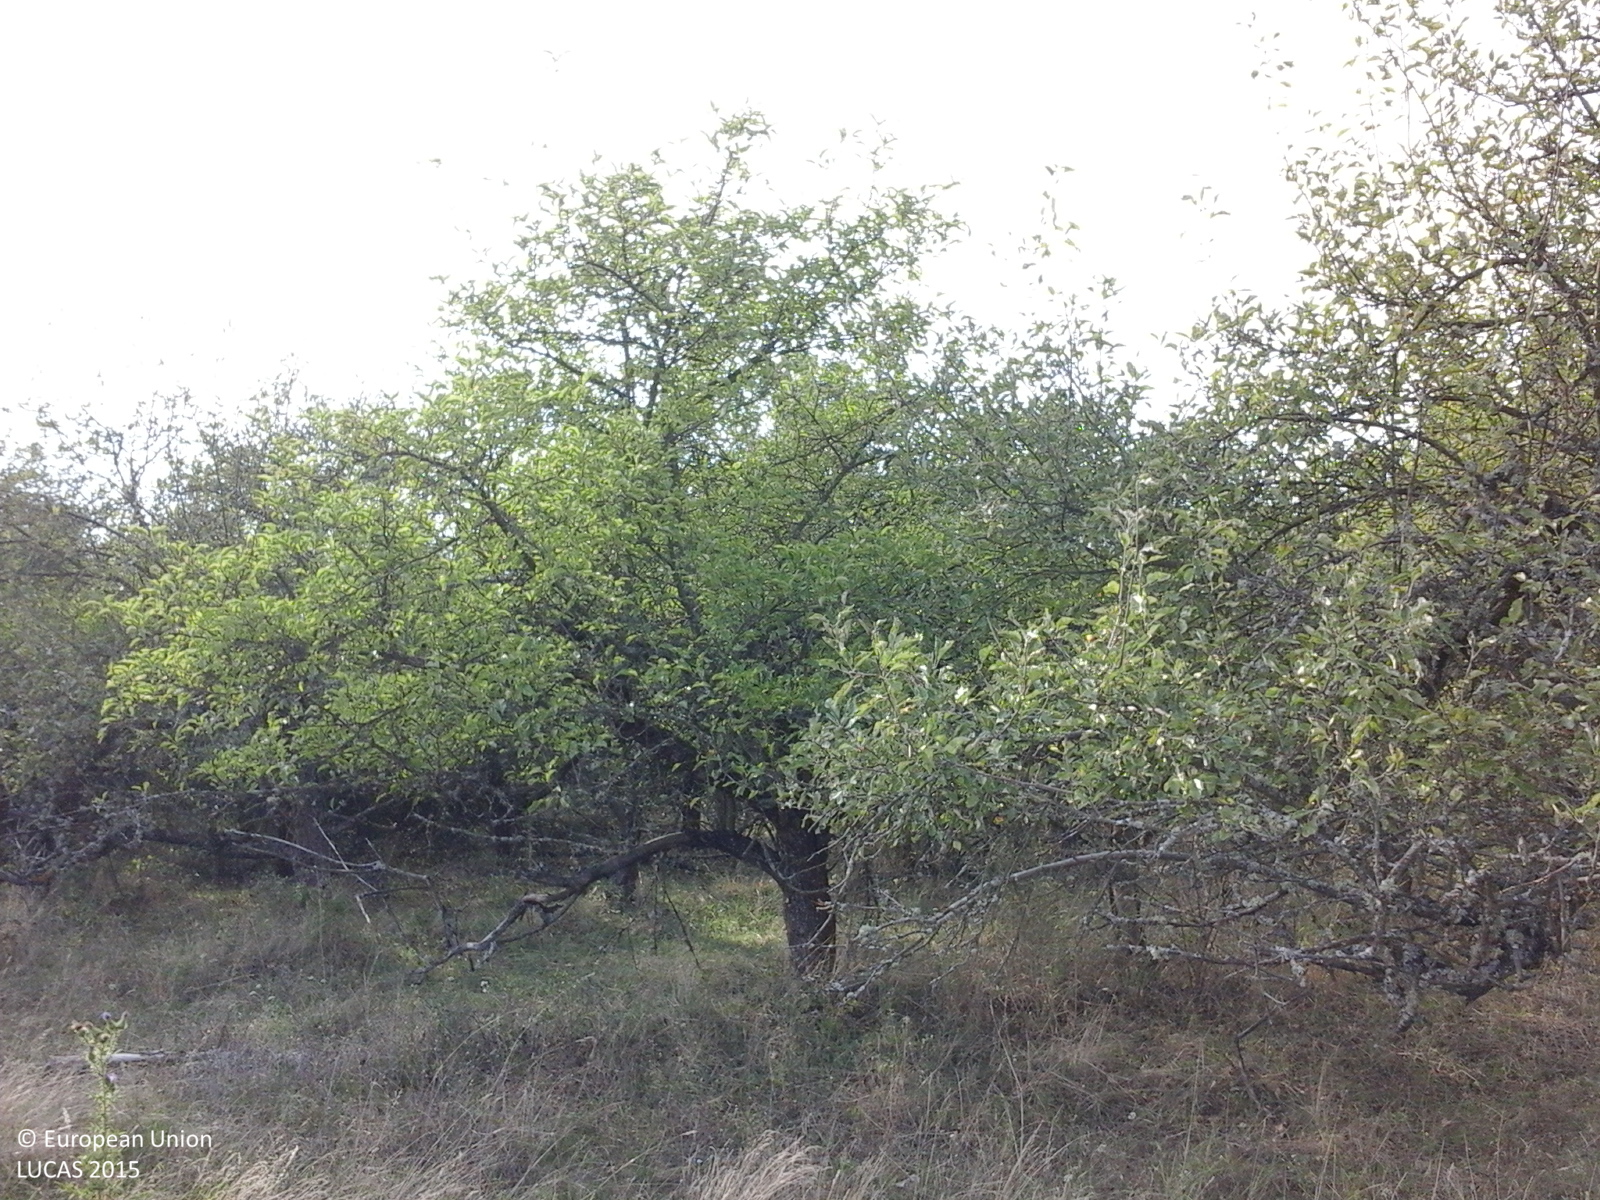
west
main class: Cropland
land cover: Apple fruit
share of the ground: > 75 %
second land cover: Grassland without tree/shrub cover
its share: > 75 %
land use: Agriculture (excluding fallow land and kitchen gardens)
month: August
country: RO
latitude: 46.0570
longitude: 21.6576
